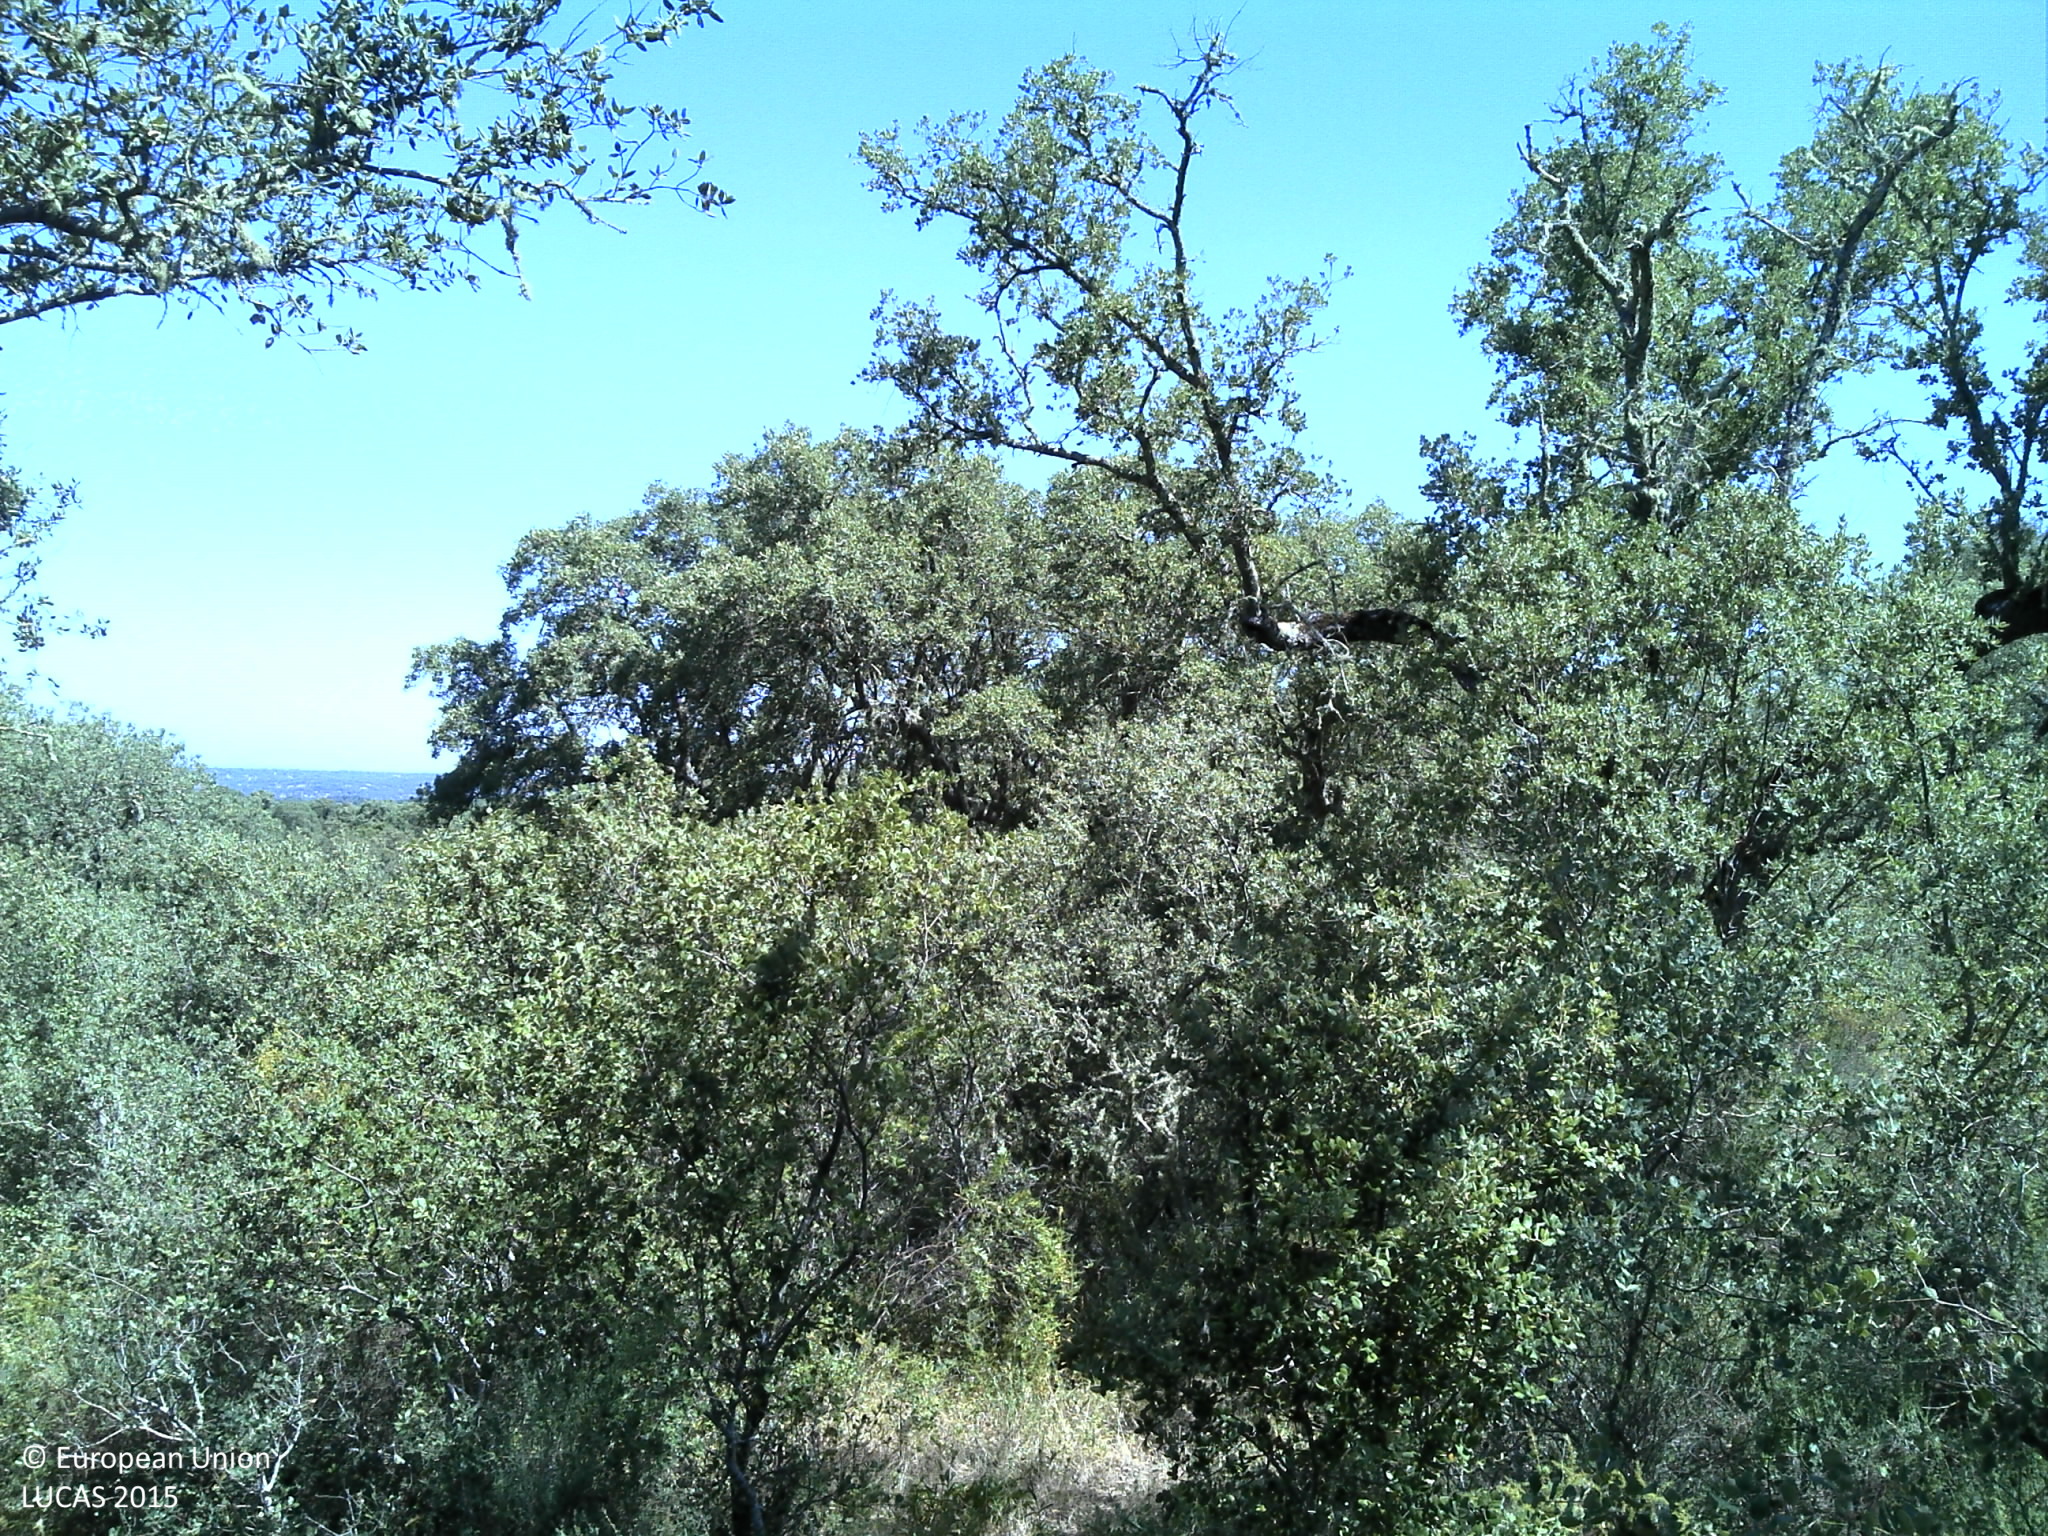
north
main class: Woodland
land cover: Broadleaved woodland
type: broadleaved evergreen forest
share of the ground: > 75 %
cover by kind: broadleaved forest trees 80 %, shrubs 20 %
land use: Forestry
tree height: > 5 m
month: May
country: PT
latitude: 38.8445
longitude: -8.1038
